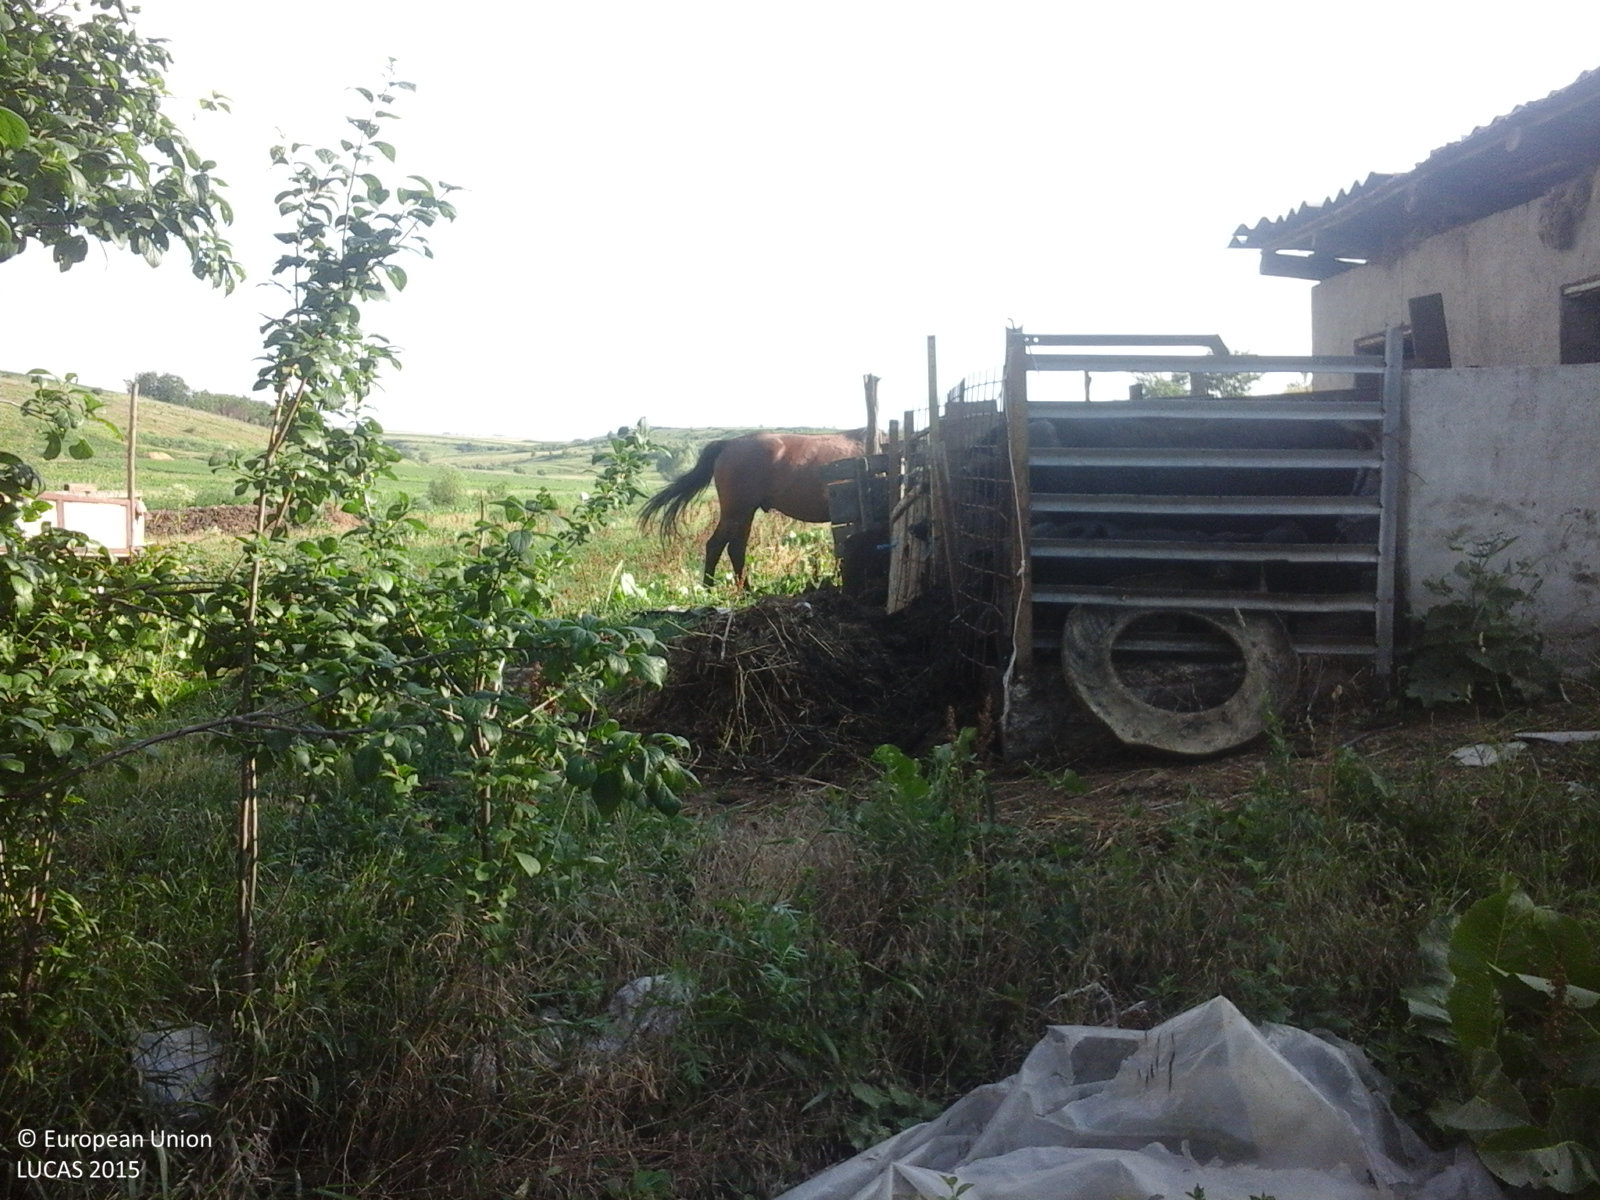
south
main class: Grassland
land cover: Grassland without tree/shrub cover
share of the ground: > 75 %
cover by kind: herbaceous plants 100 %
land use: Agriculture (excluding fallow land and kitchen gardens)
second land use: Residential
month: June
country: RO
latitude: 47.1618
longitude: 27.0255
